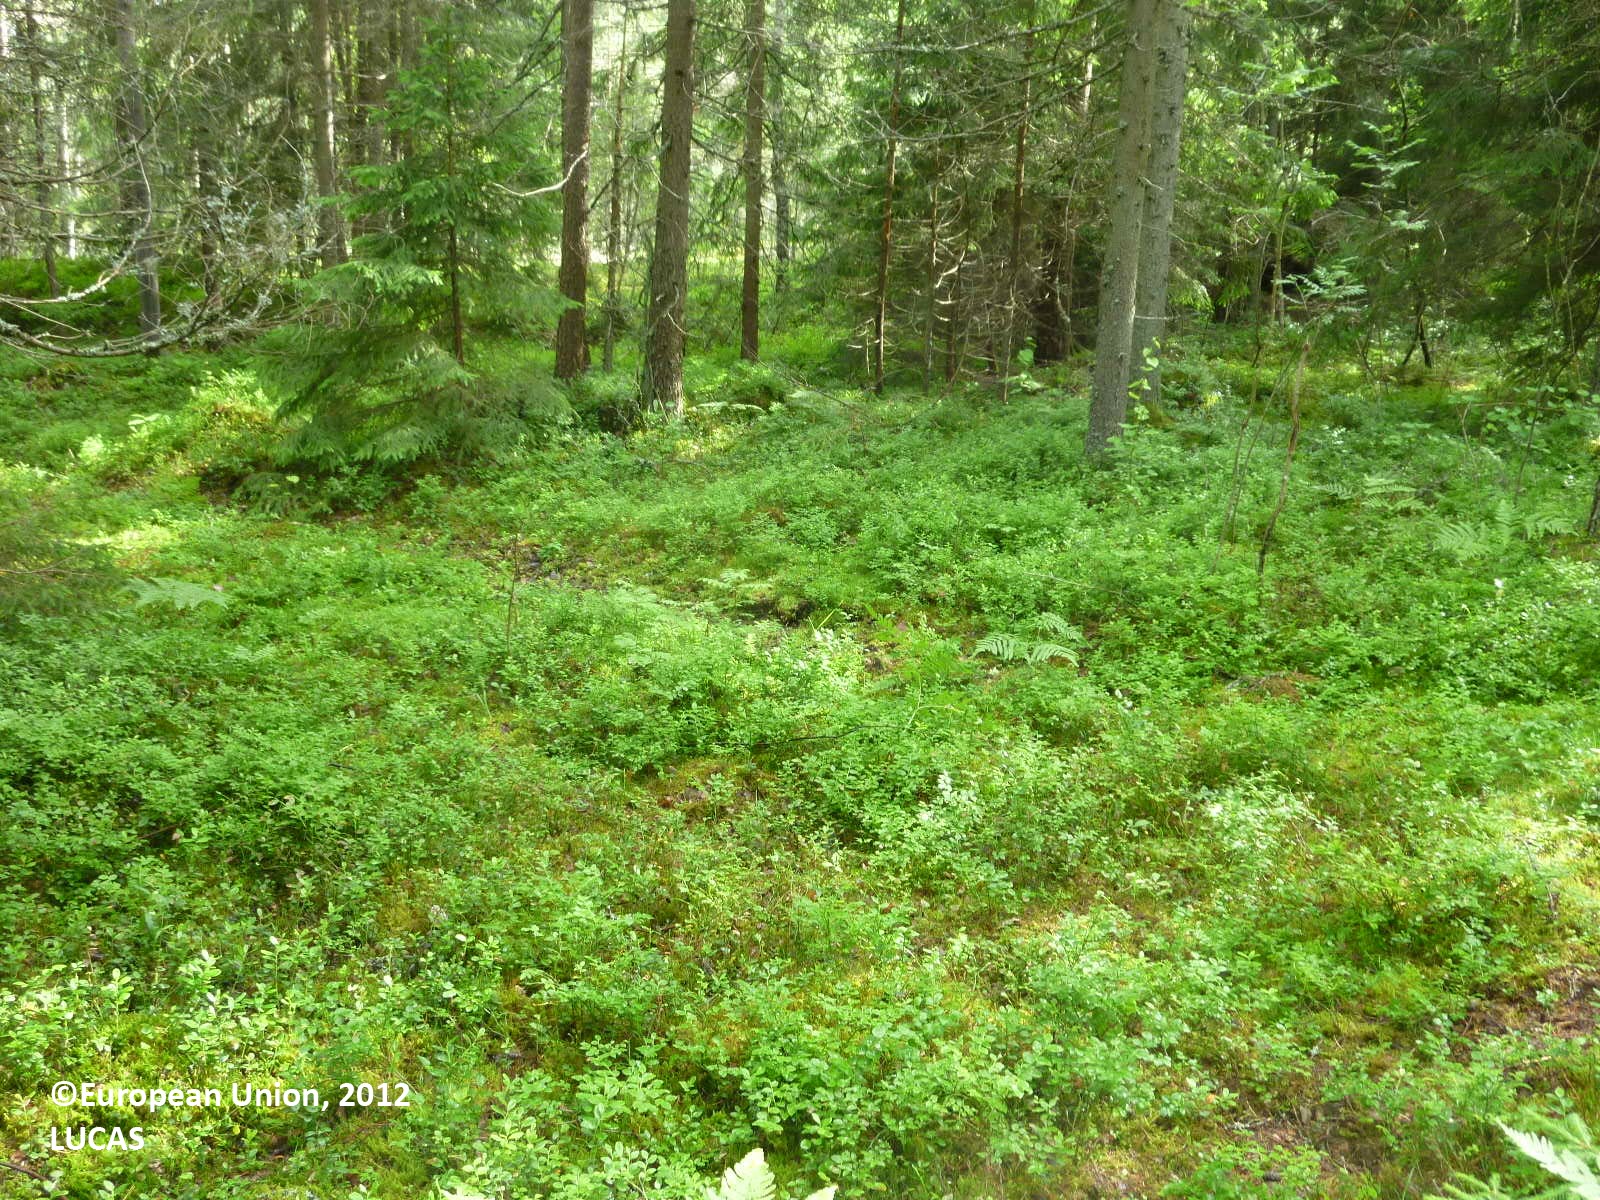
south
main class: Woodland
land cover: Spruce dominated coniferous woodland
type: boreal forest
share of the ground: 50 - 75 %
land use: Forestry
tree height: > 5 m
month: June
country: FI
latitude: 60.2671
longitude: 22.6366
